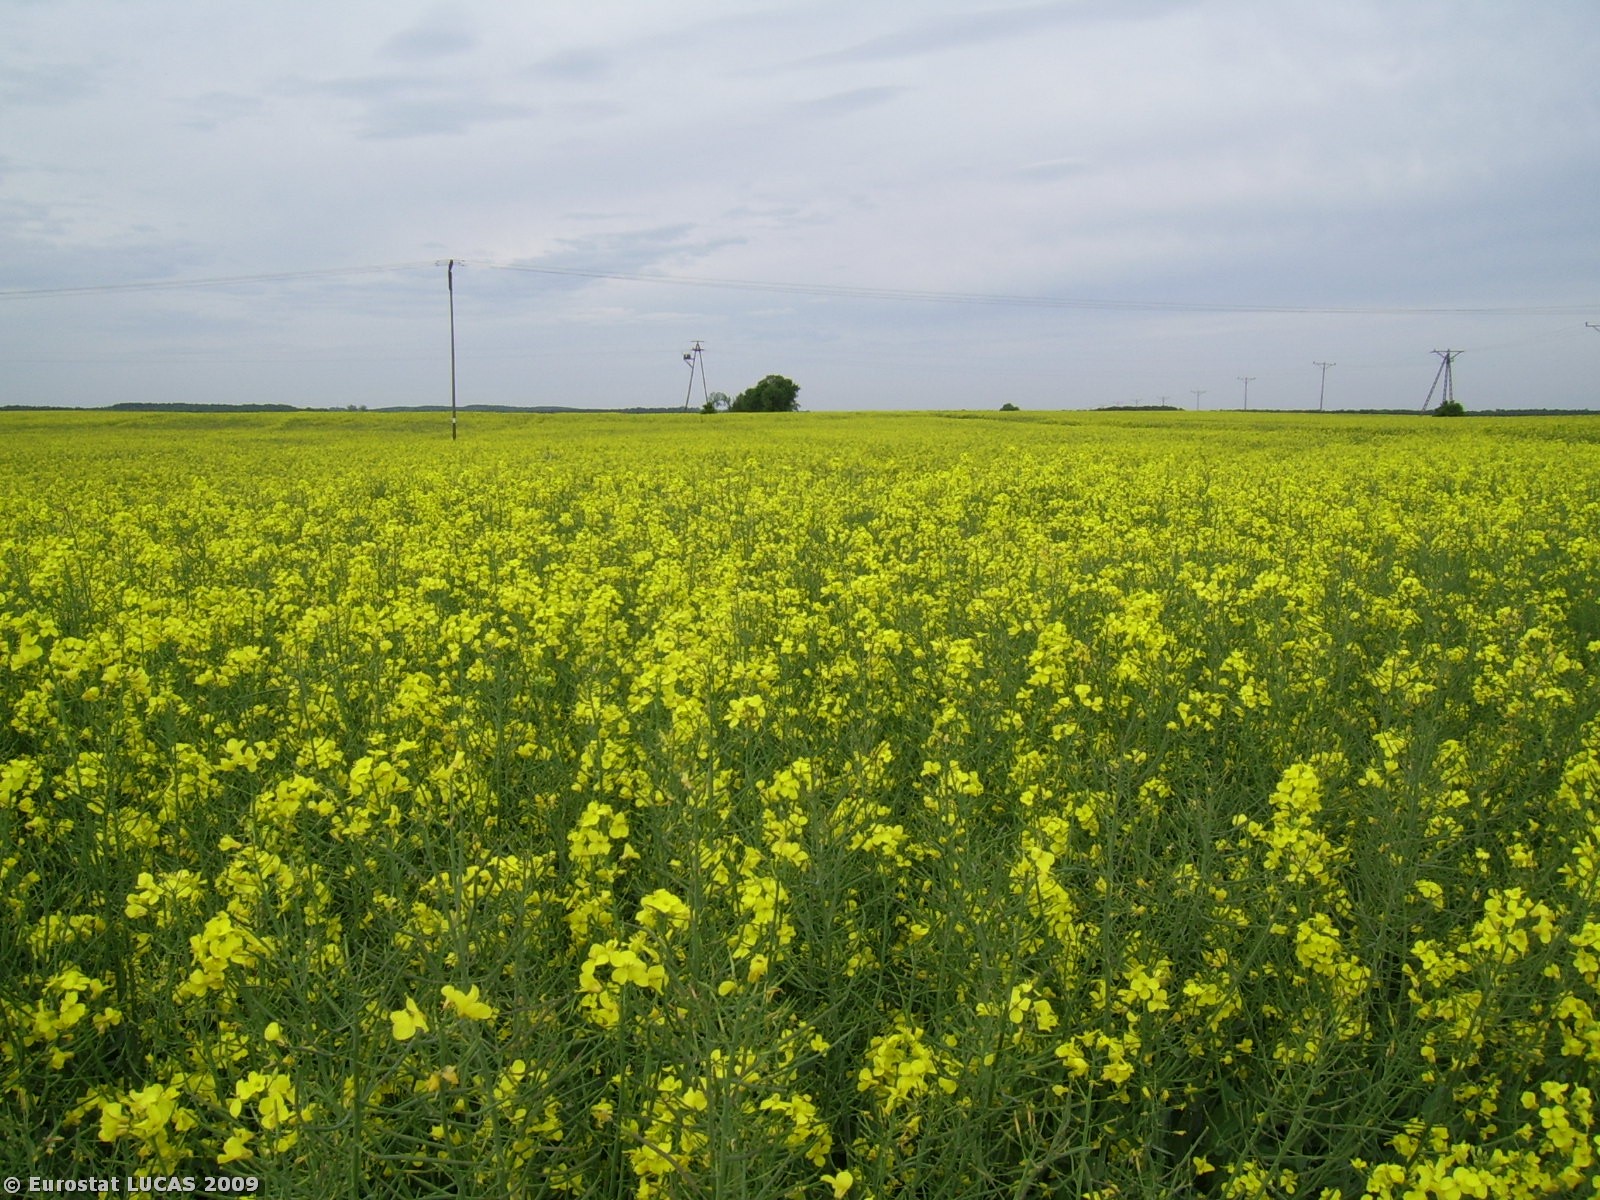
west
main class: Cropland
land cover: Rape and turnip rape
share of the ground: > 75 %
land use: Agriculture (excluding fallow land and kitchen gardens)
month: May
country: PL
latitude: 53.0147
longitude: 17.6597
